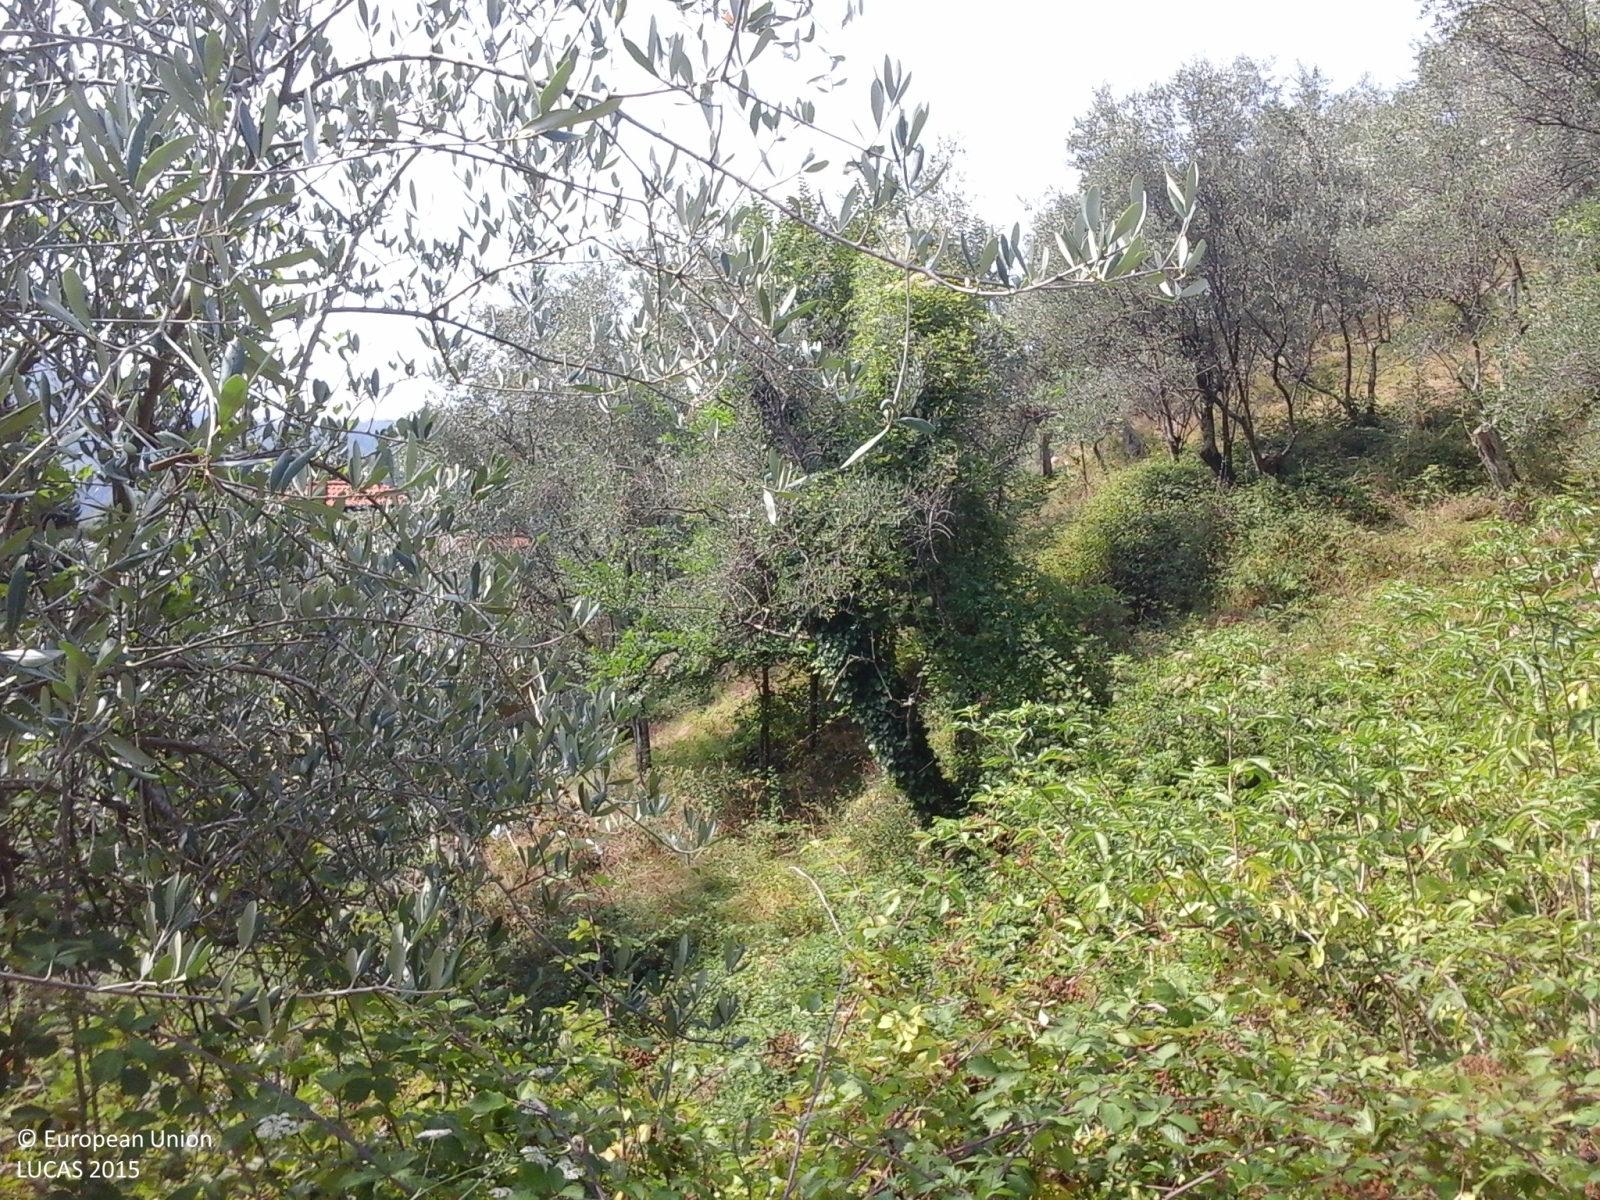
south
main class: Cropland
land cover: Olive groves
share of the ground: > 75 %
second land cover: Grassland without tree/shrub cover
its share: > 75 %
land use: Agriculture (excluding fallow land and kitchen gardens)
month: August
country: IT
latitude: 43.9533
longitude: 10.2859
